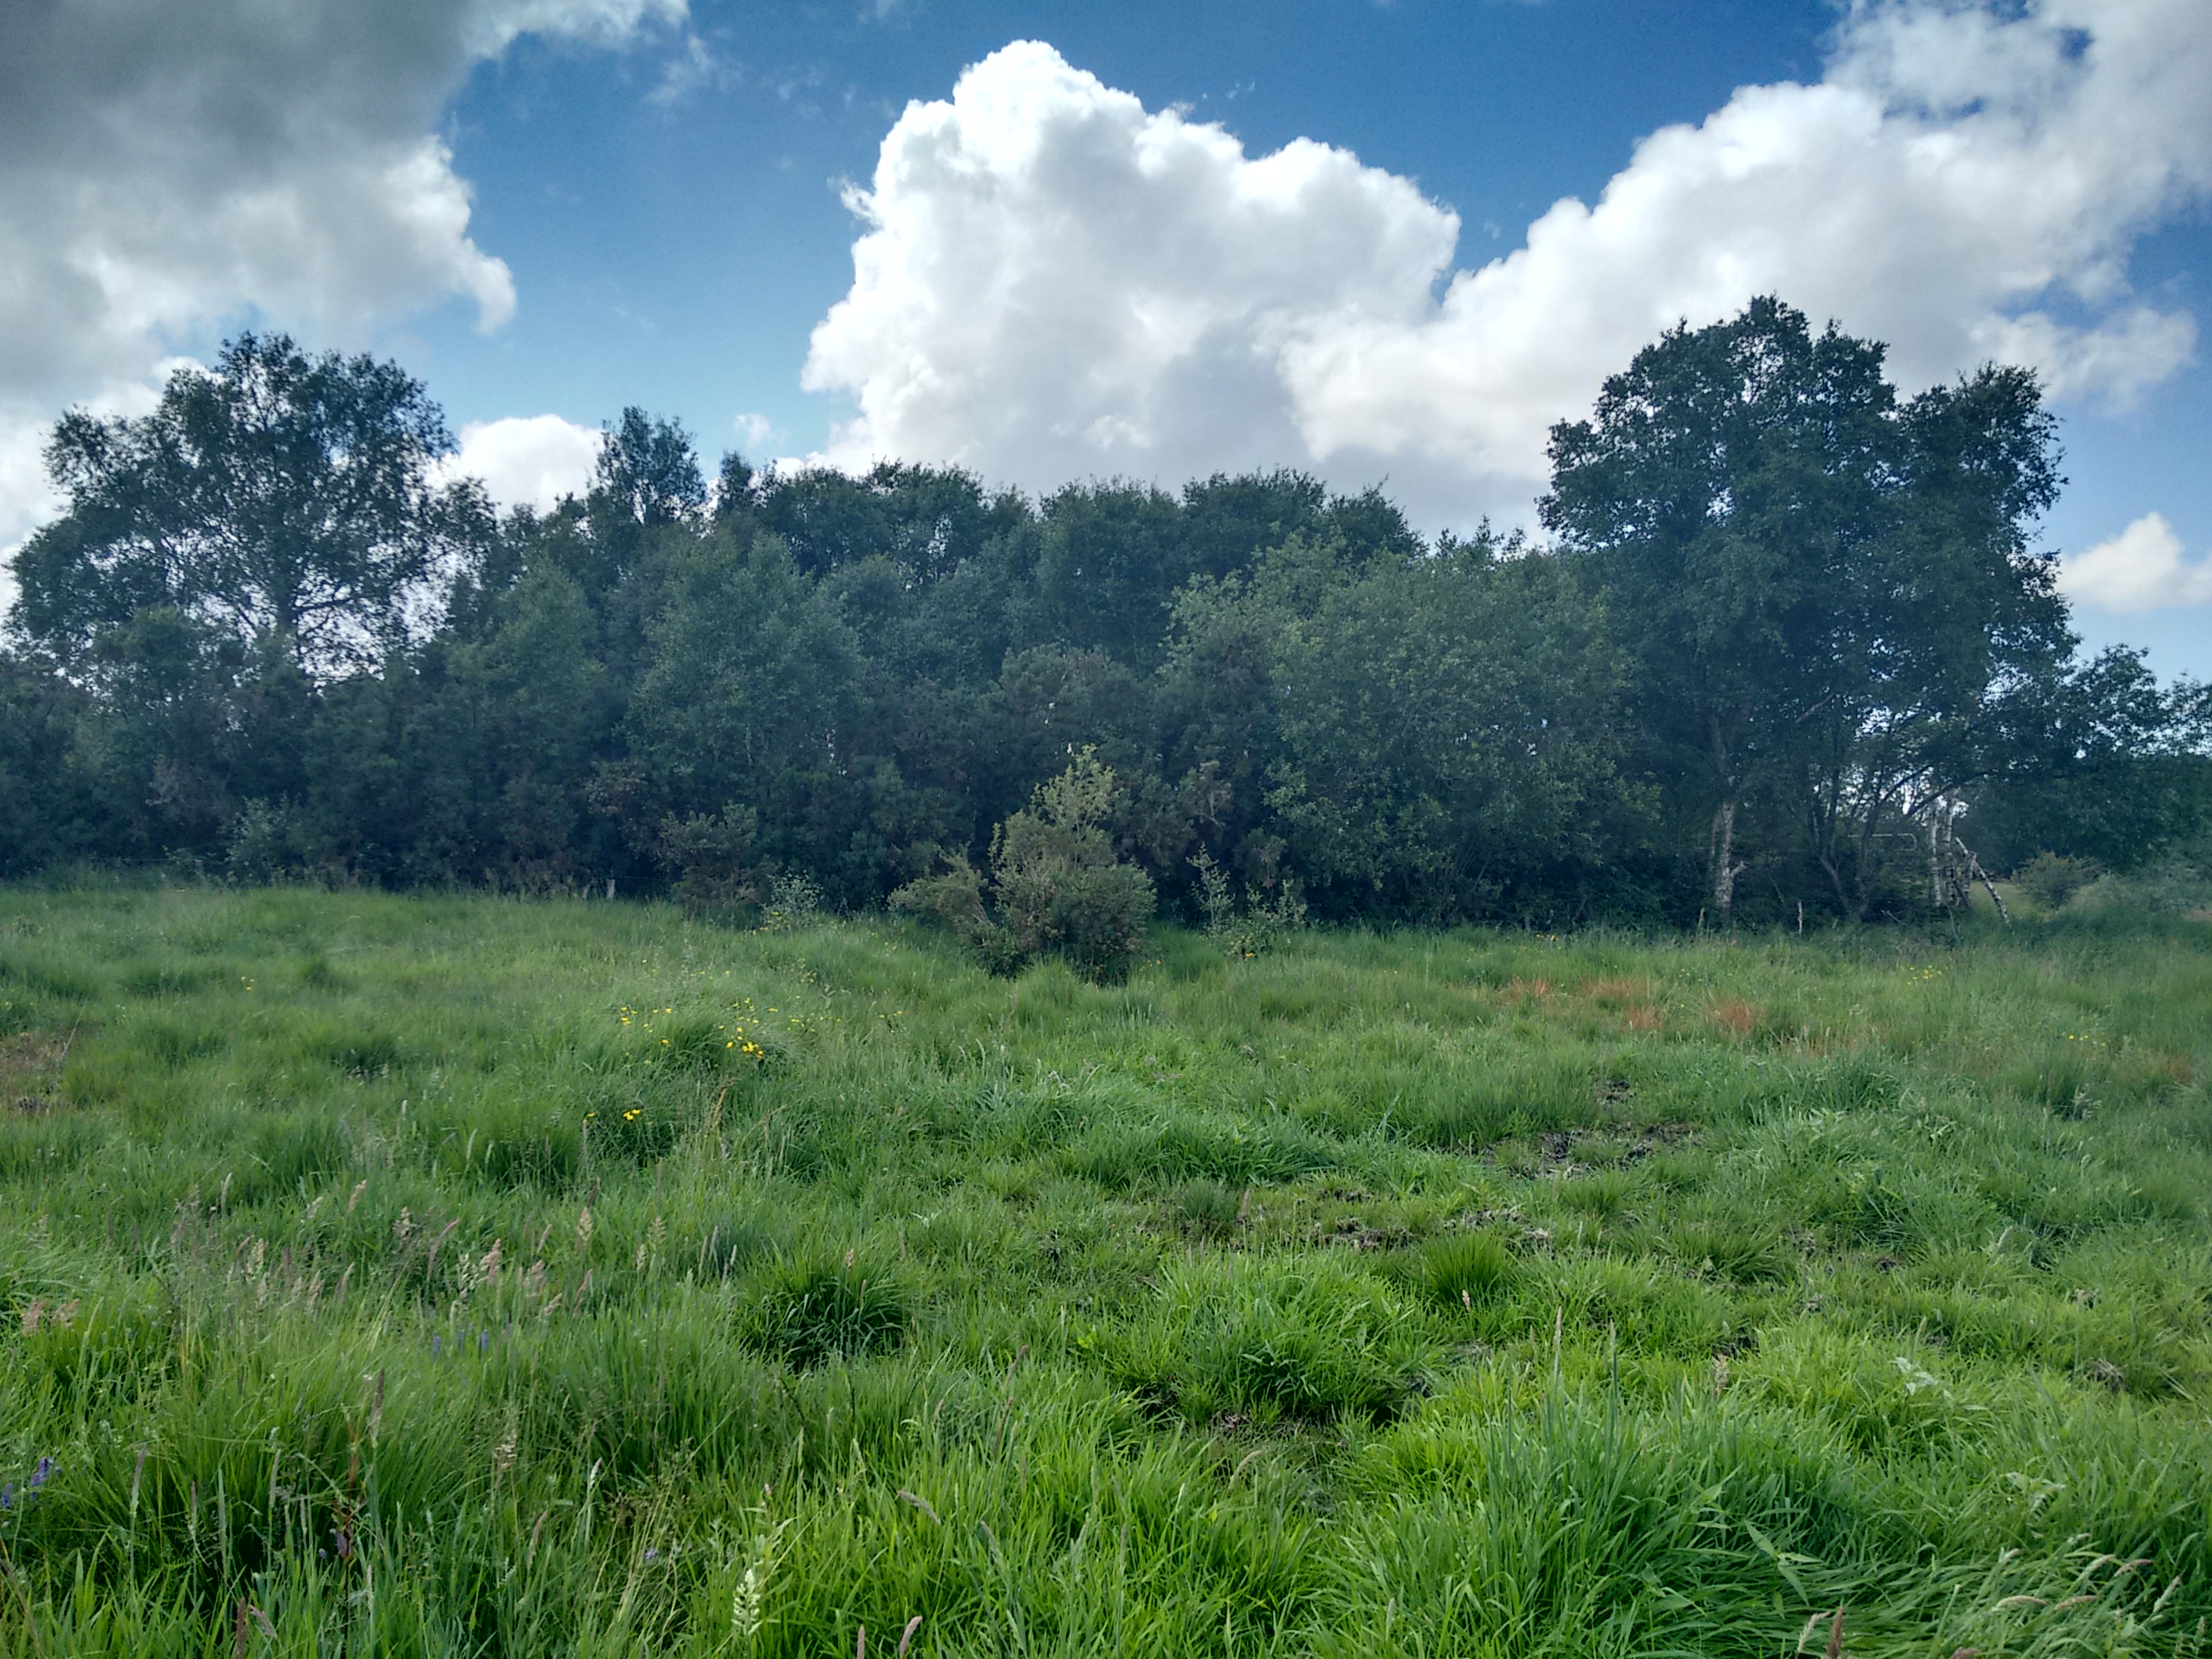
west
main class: Grassland
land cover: Grassland without tree/shrub cover
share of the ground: > 75 %
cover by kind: herbaceous plants 95 %, consolidated bare surface 5 %
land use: Agriculture (excluding fallow land and kitchen gardens)
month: June
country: IE
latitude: 53.3417
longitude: -7.9102
